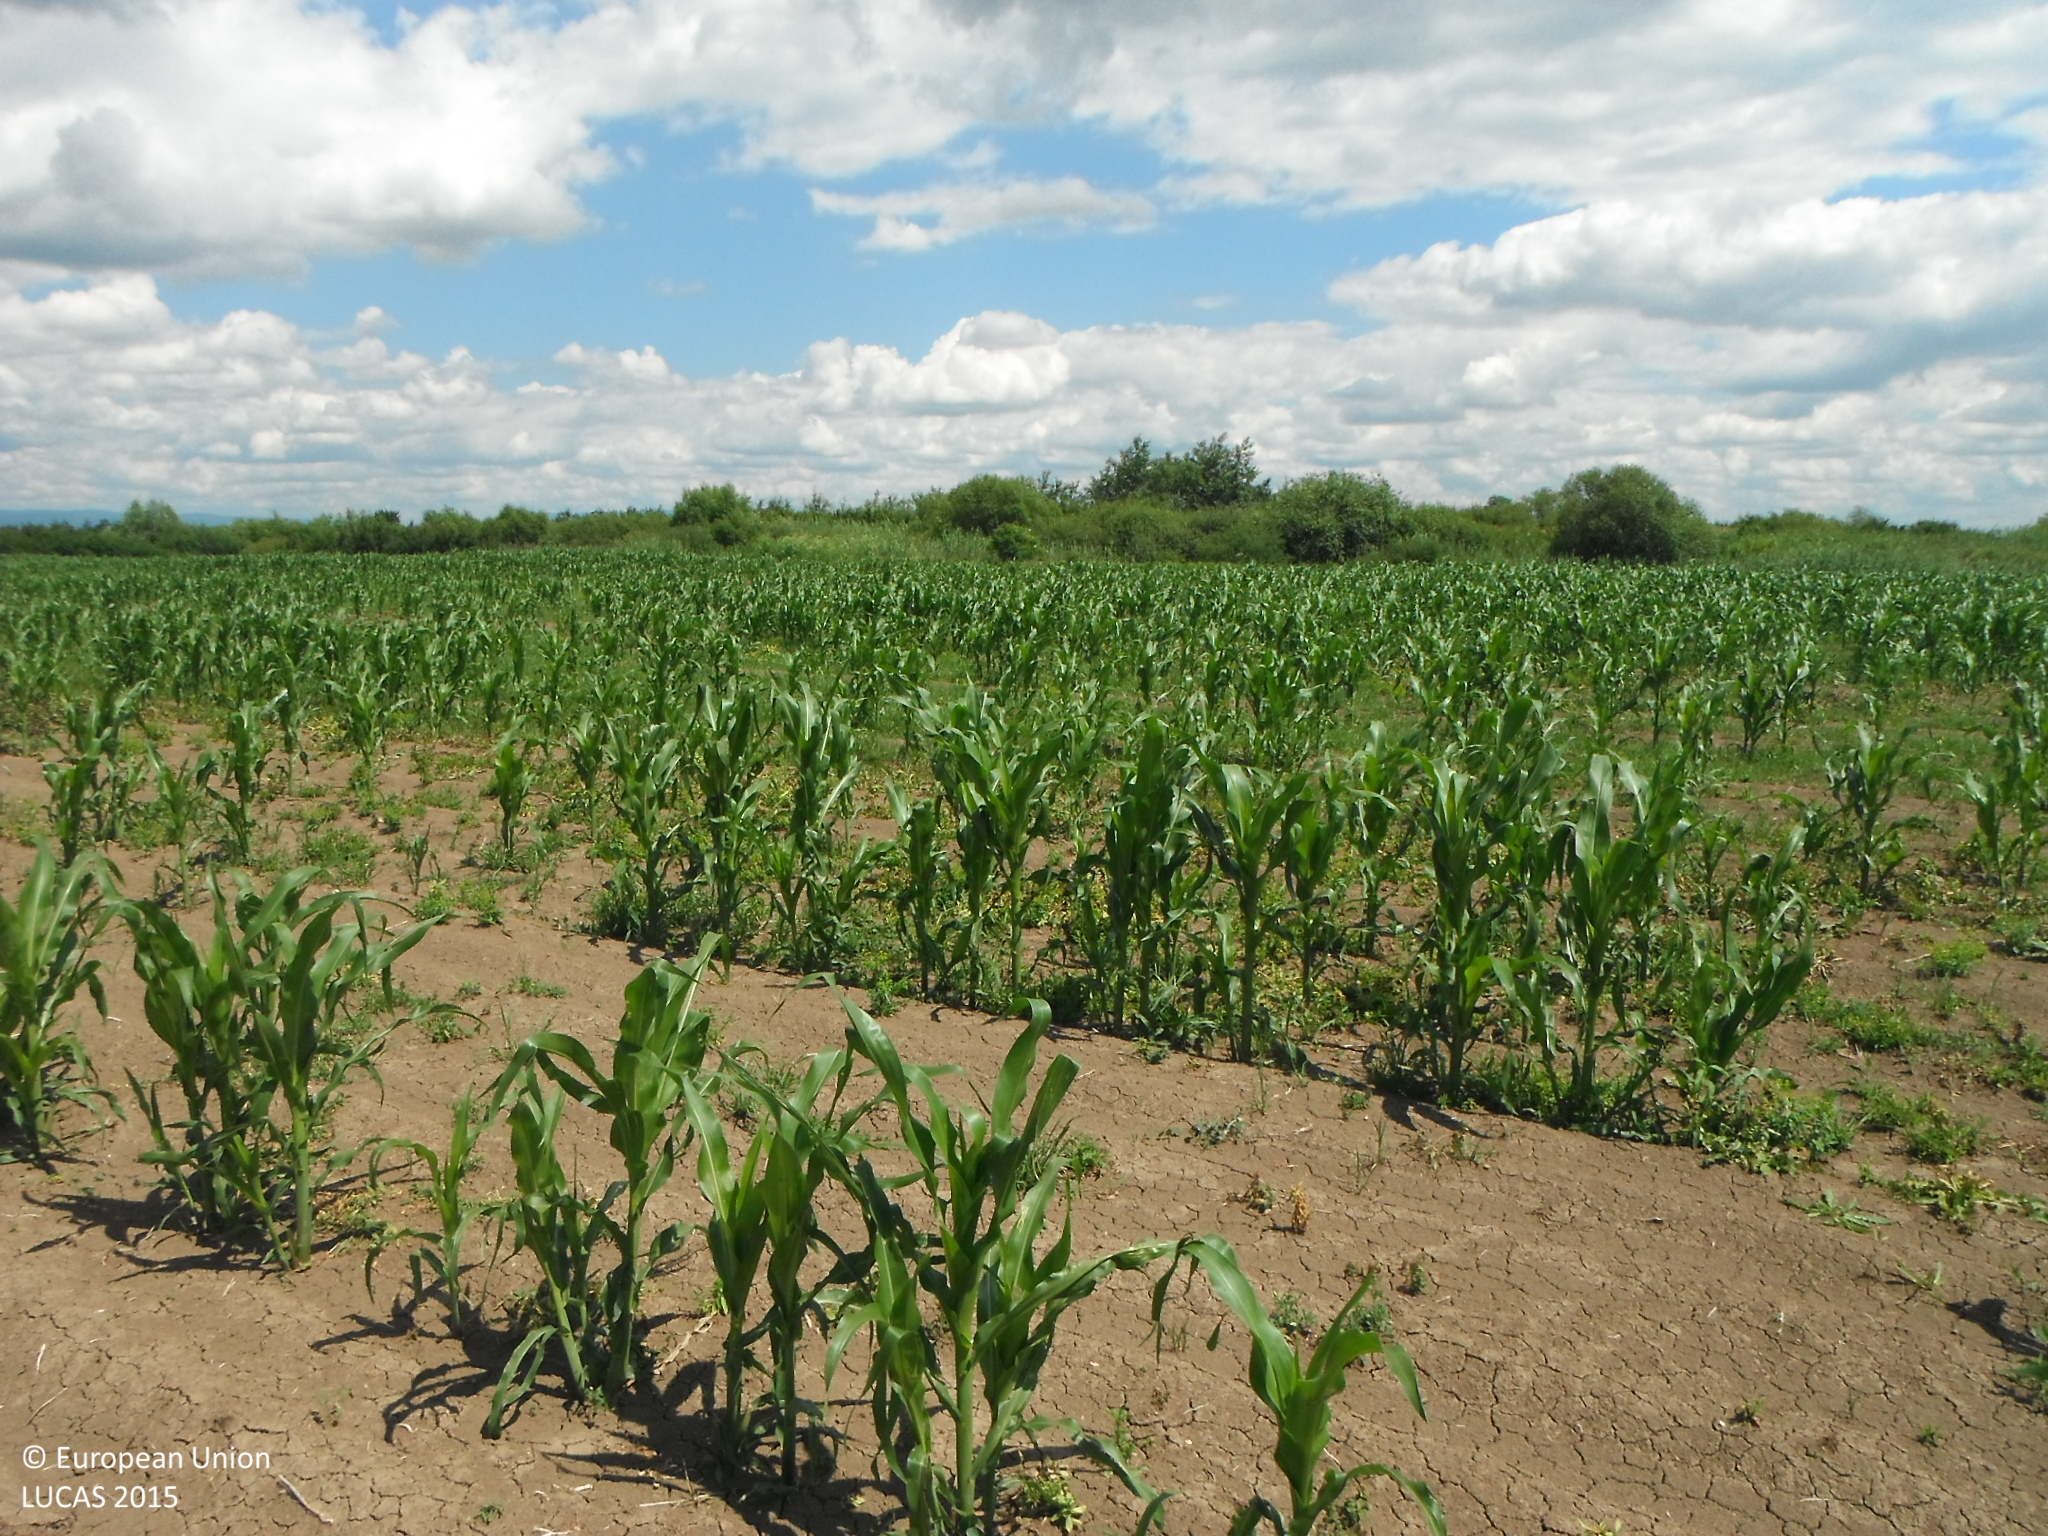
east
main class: Cropland
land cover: Maize
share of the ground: < 10 %
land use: Agriculture (excluding fallow land and kitchen gardens)
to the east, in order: Maize; Spontaneously vegetated surfaces; Shrubland without tree cover; Grassland without tree/shrub cover; Railways; Grassland without tree/shrub cover; Shrubland with sparse tree cover; Common wheat
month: June
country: SK
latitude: 48.7079
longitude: 21.8619
